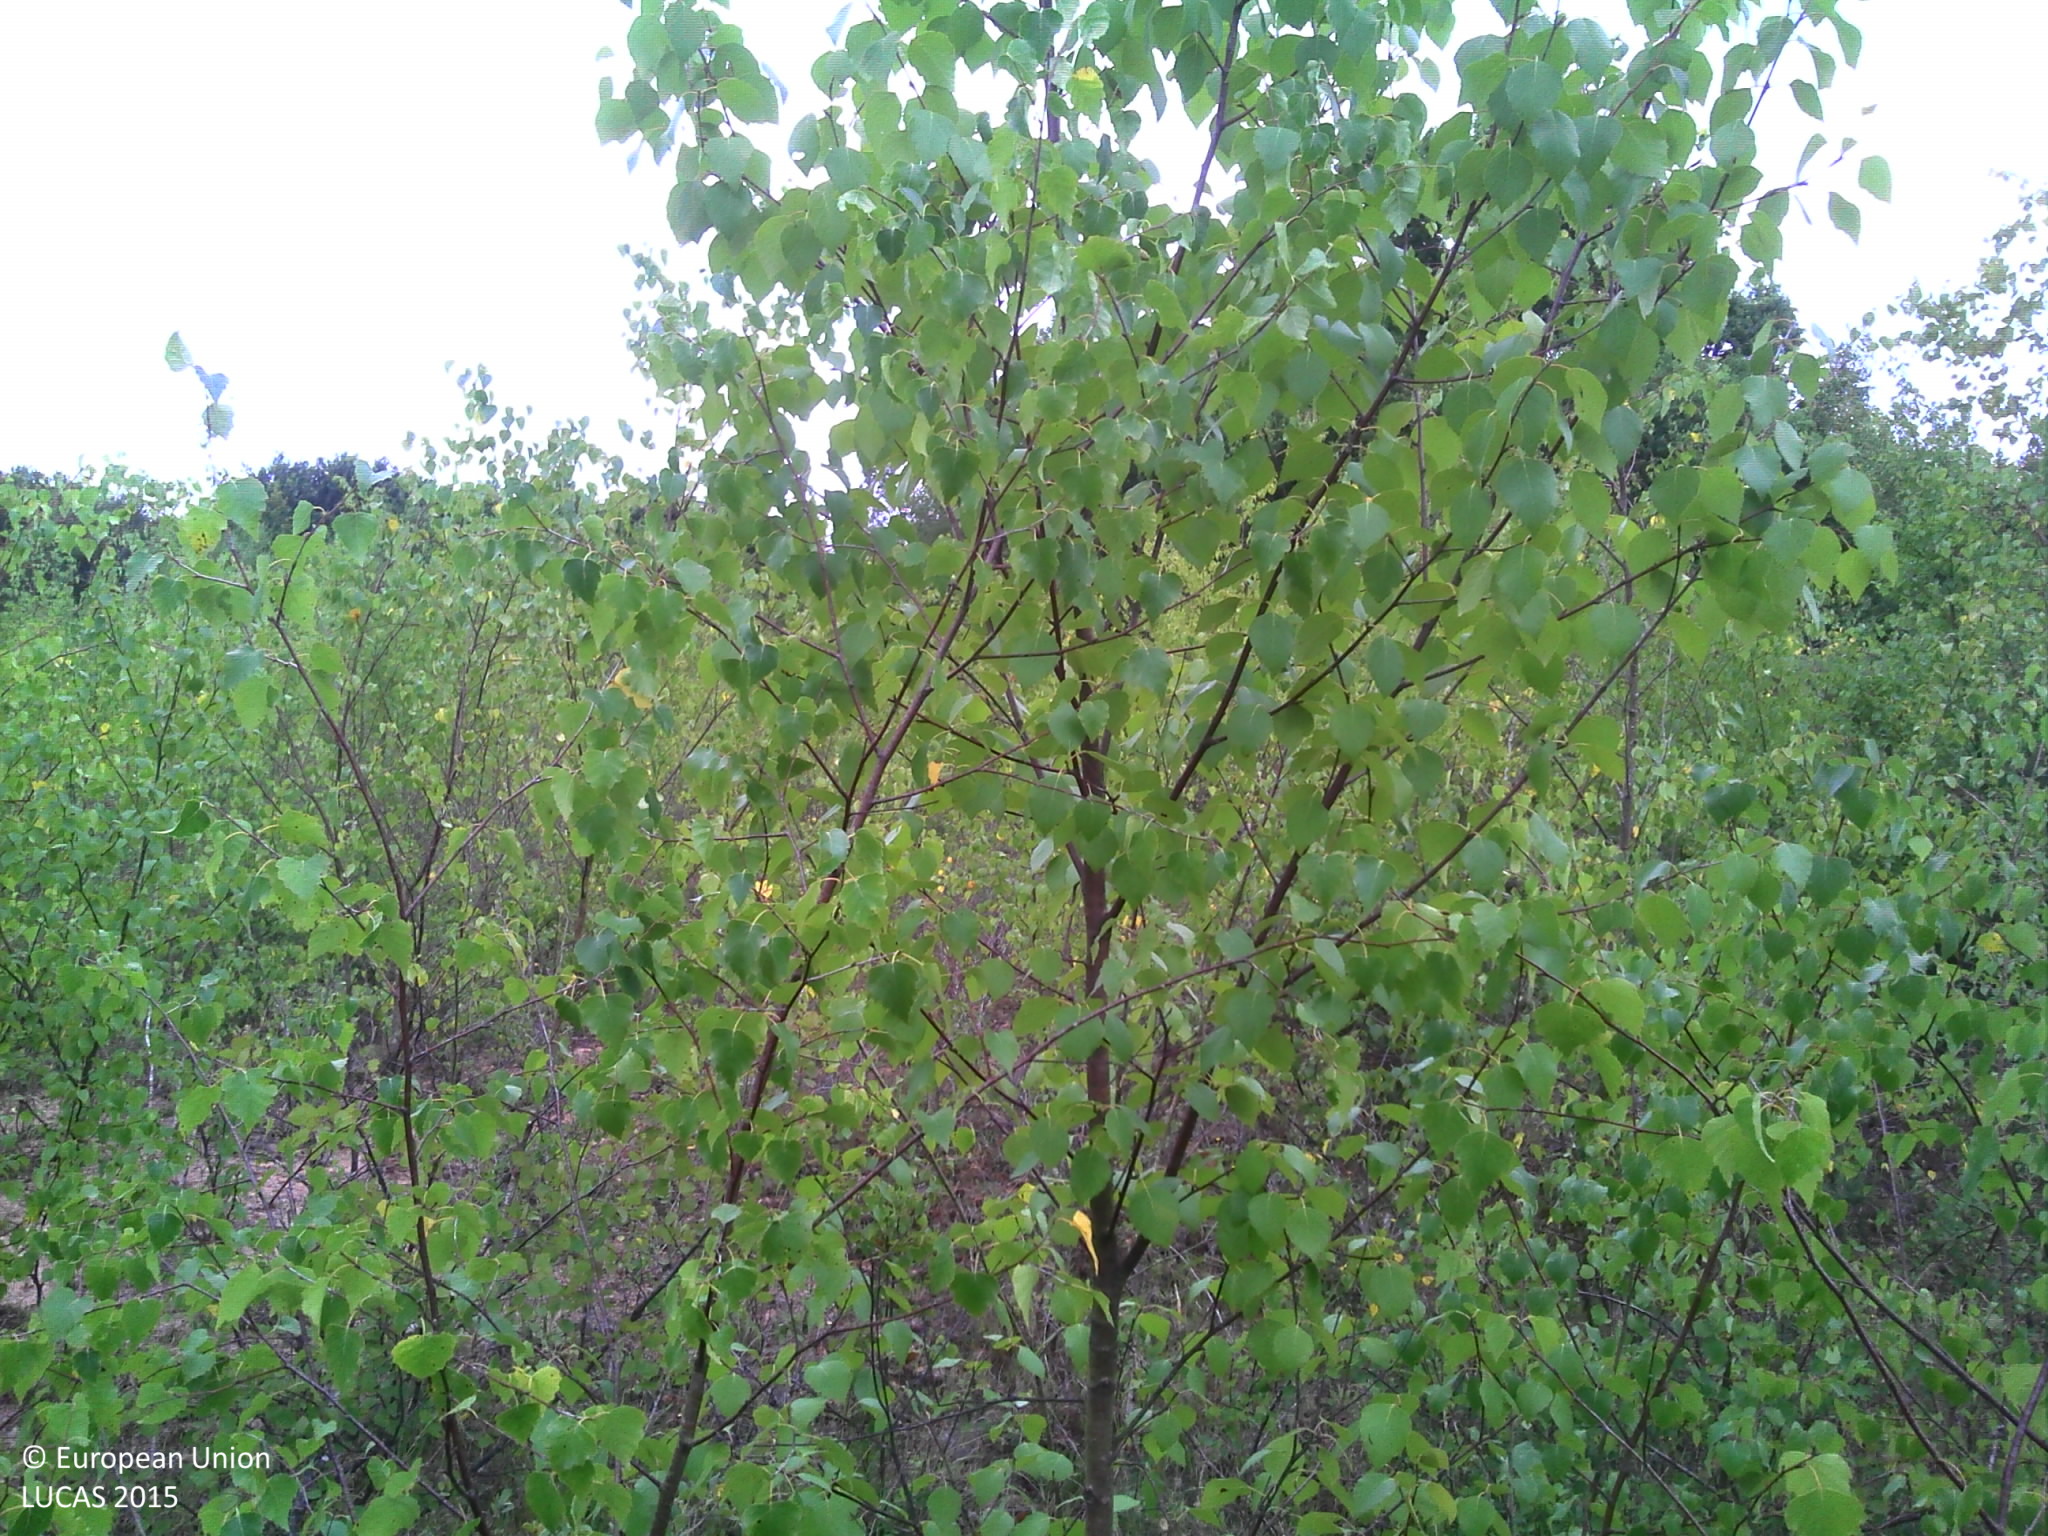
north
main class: Woodland
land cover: Broadleaved woodland
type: mesophytic deciduous forest
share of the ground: > 75 %
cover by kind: broadleaved forest trees 50 %, herbaceous plants 40 %, coniferous forest trees 10 %
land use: Forestry
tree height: < 5 m
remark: Temporary flooded
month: July
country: FR
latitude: 47.5650
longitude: -1.8373
